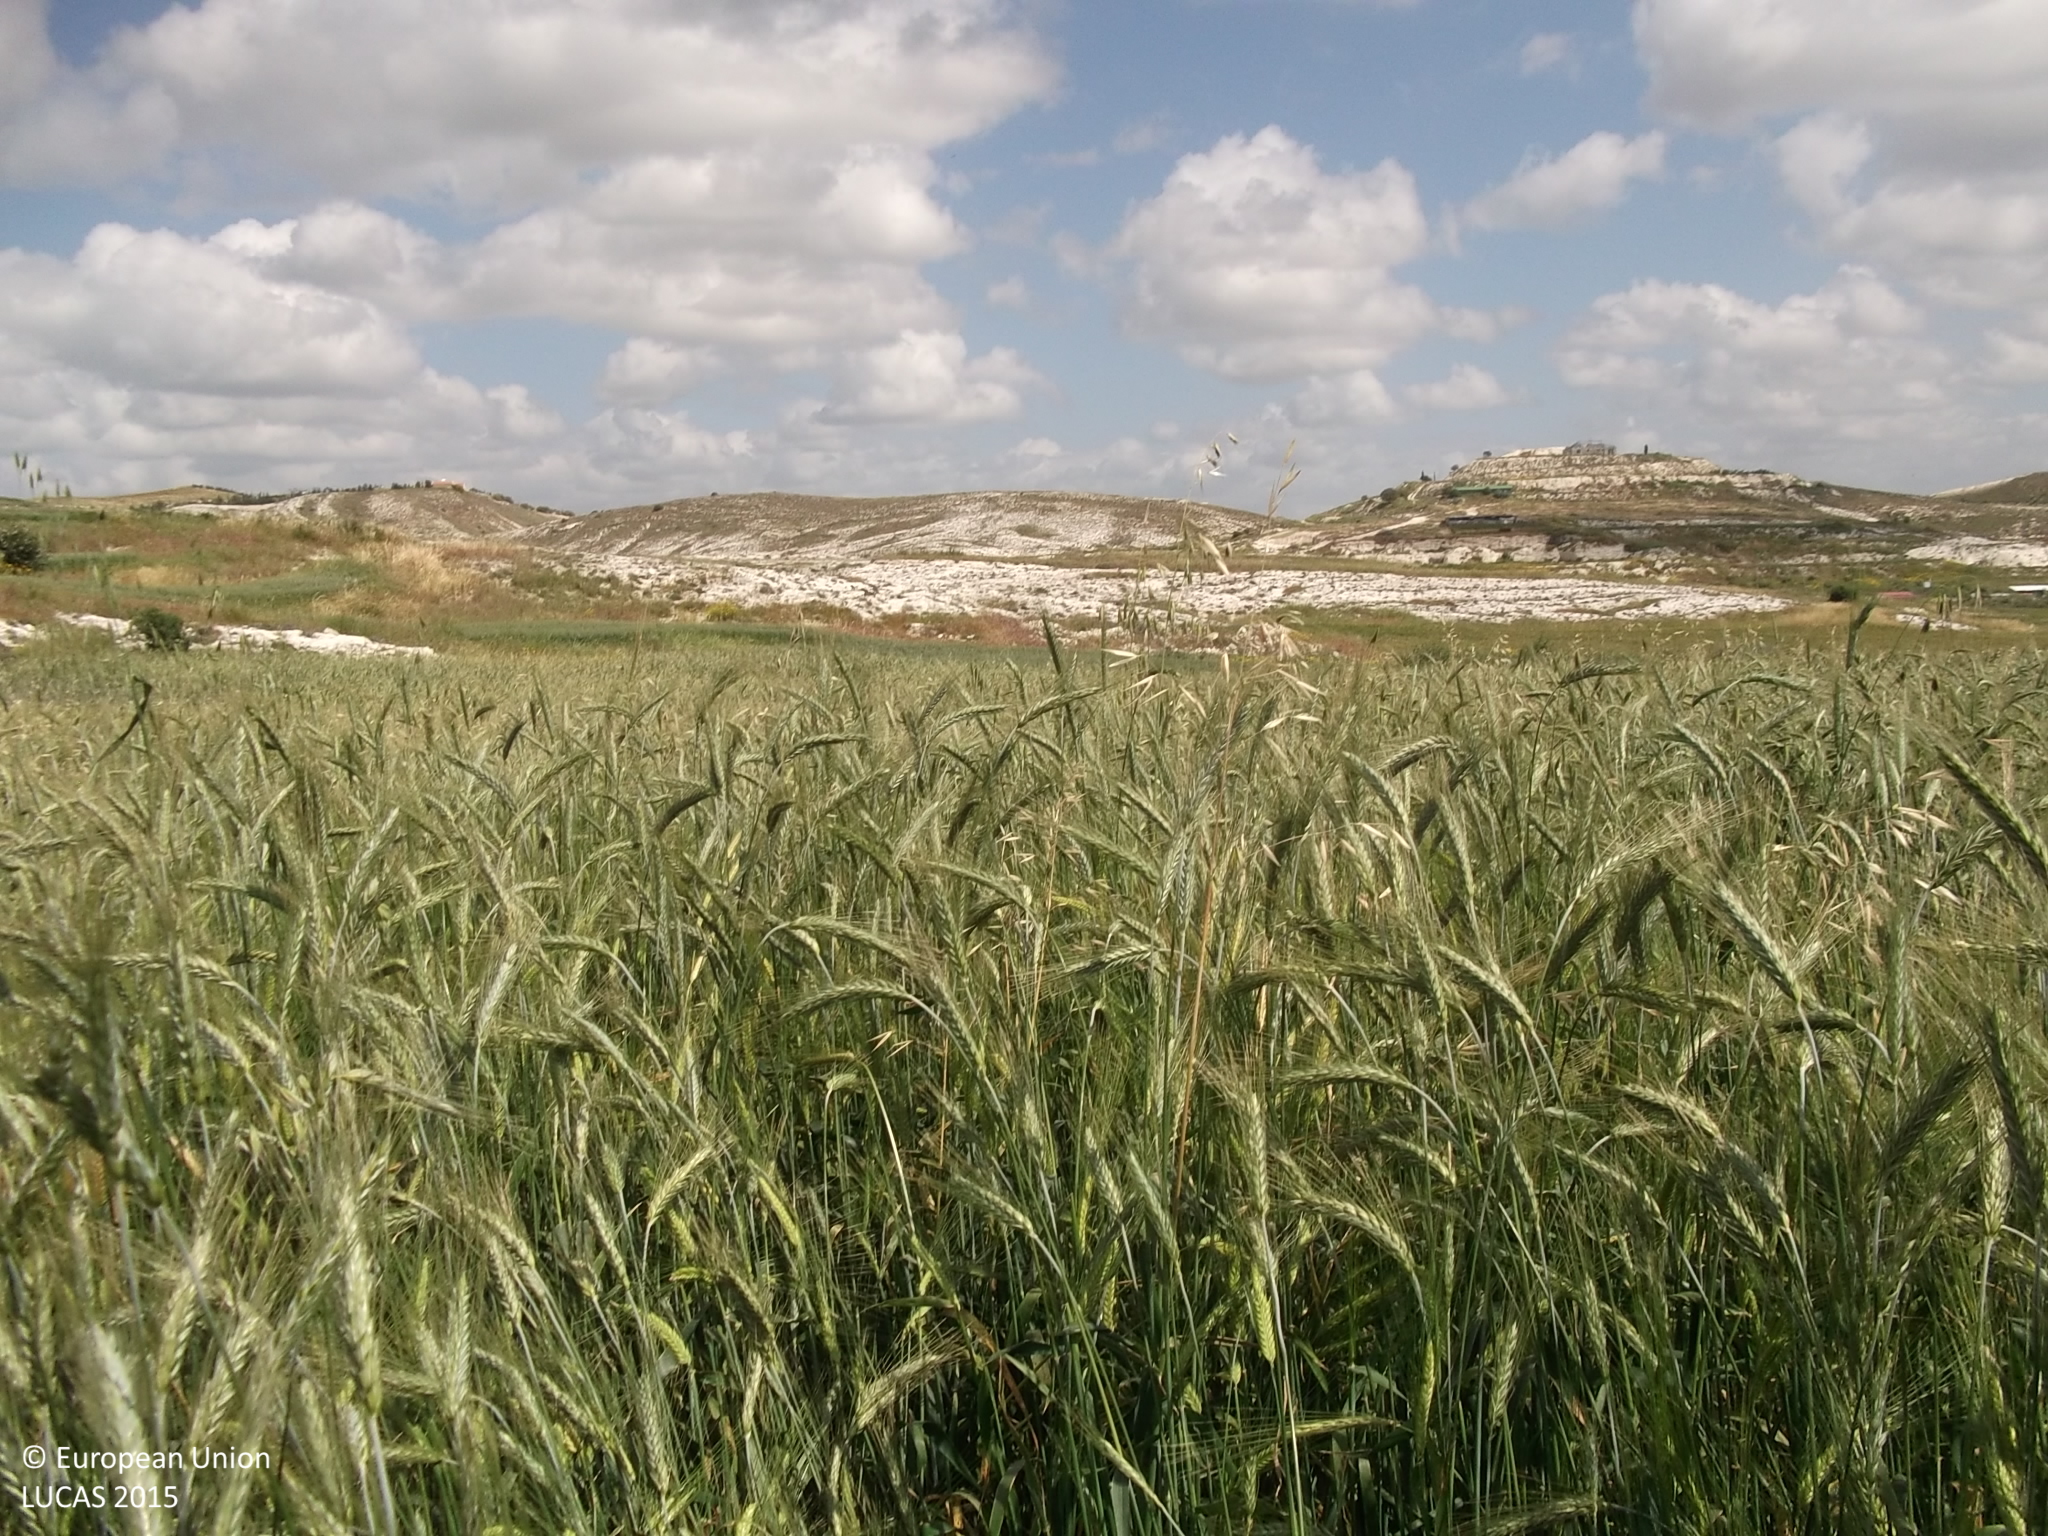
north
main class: Cropland
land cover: Common wheat
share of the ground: > 75 %
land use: Agriculture (excluding fallow land and kitchen gardens)
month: April
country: CY
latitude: 34.9806
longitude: 33.5839
